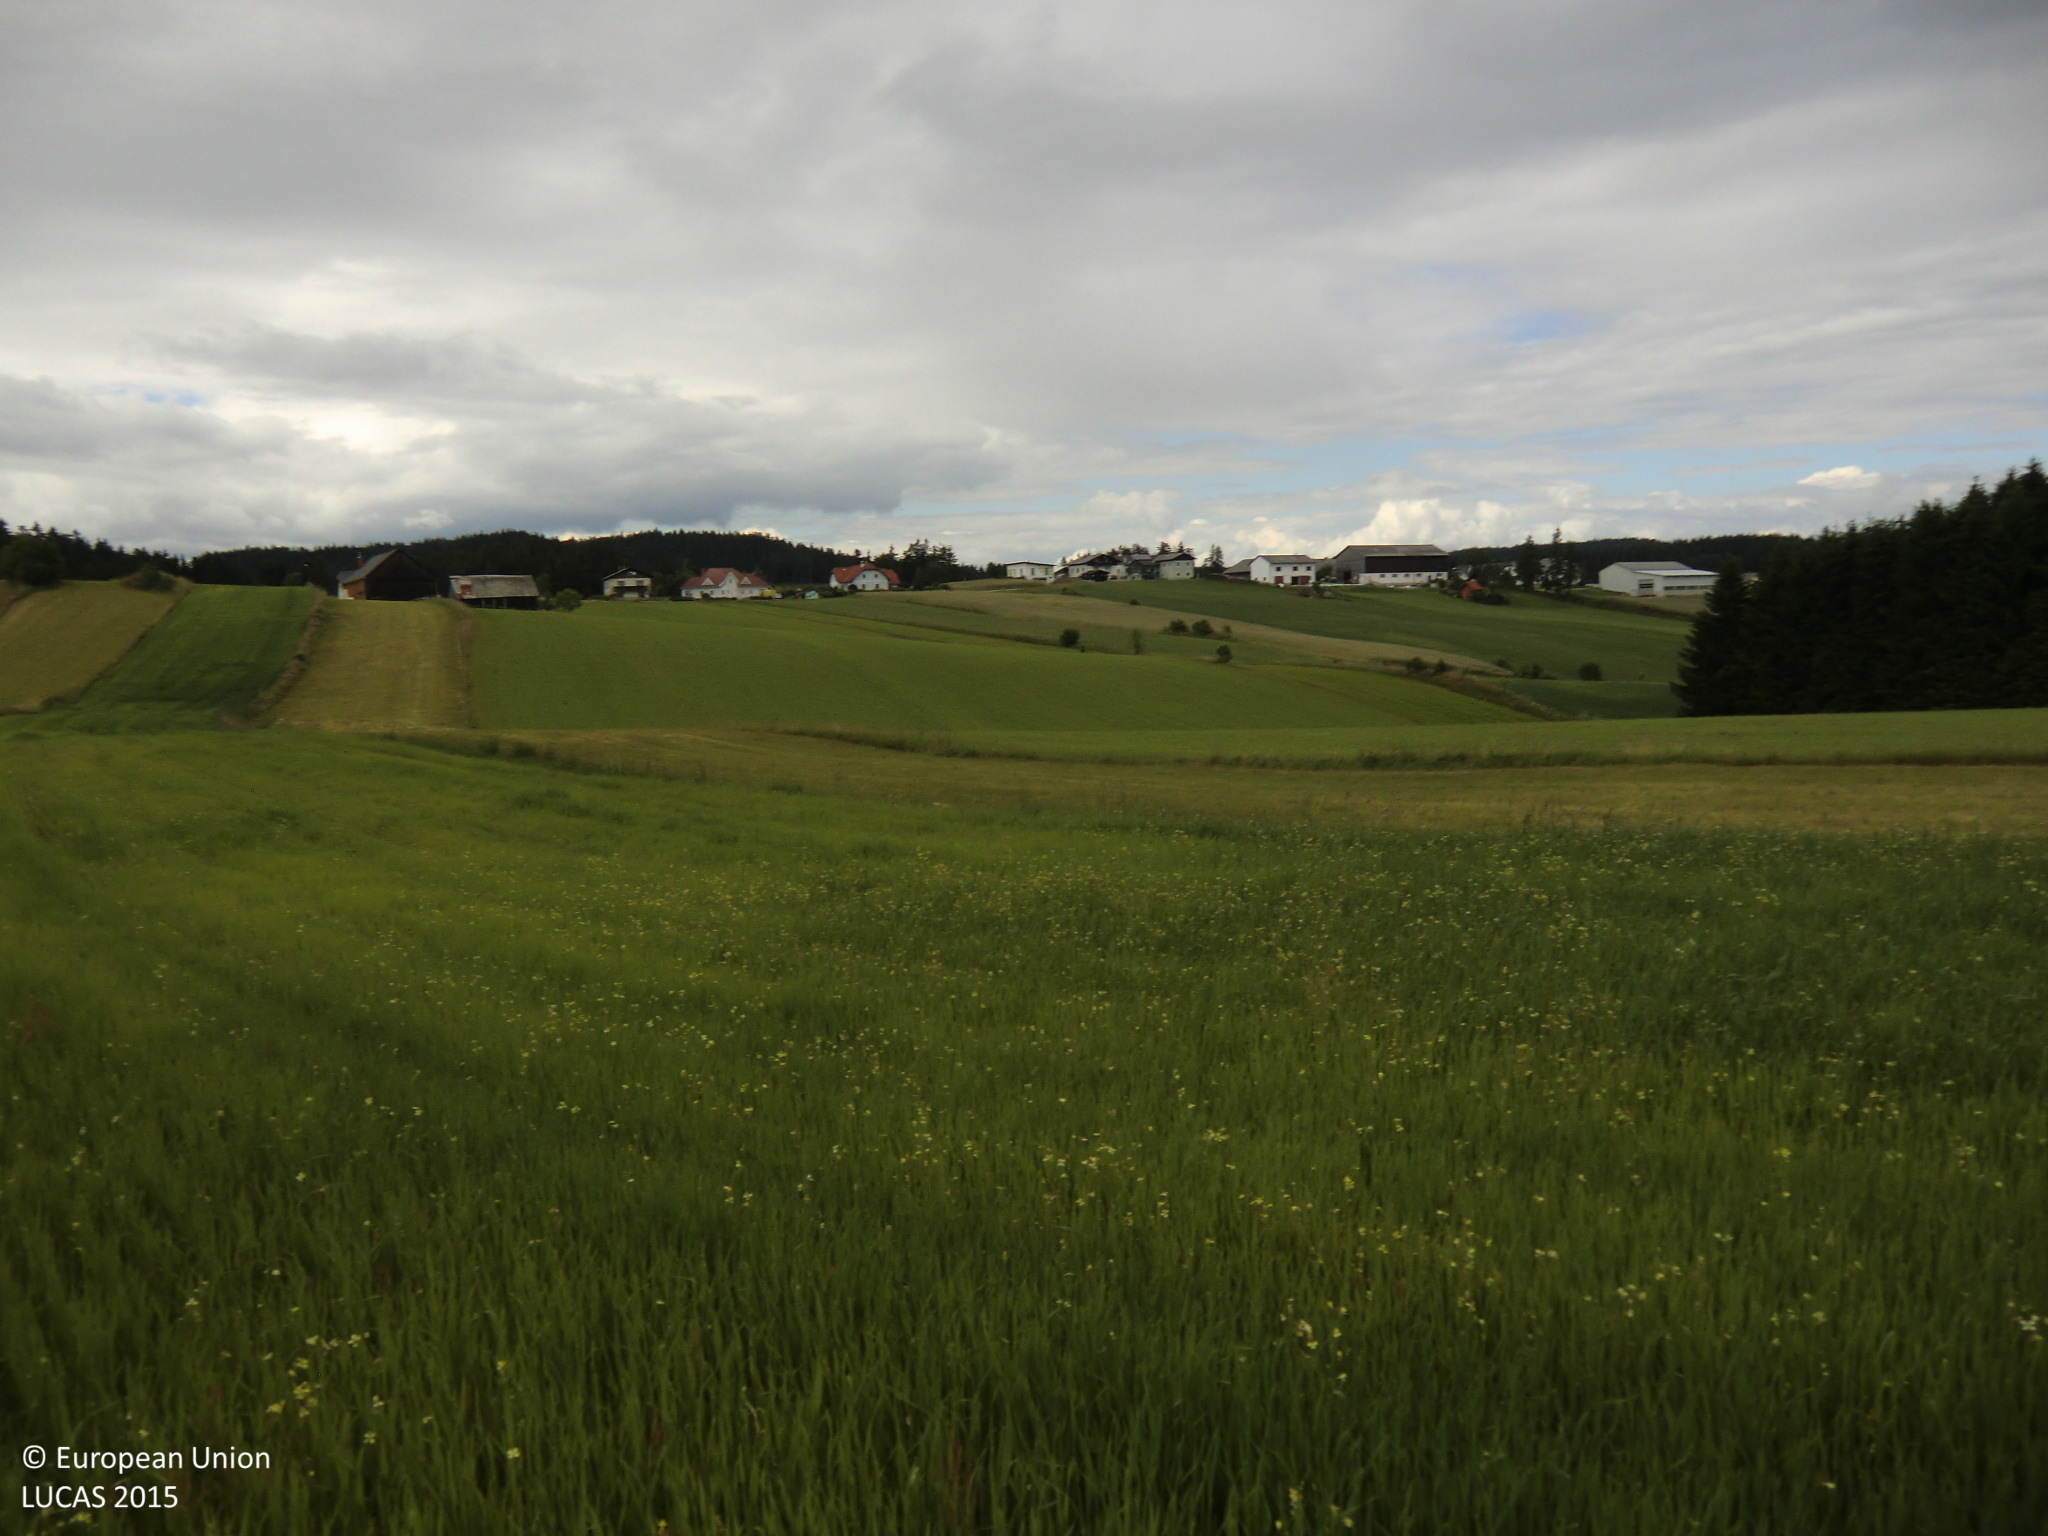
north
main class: Cropland
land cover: Rye
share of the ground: > 75 %
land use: Agriculture (excluding fallow land and kitchen gardens)
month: June
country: AT
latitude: 48.4351
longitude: 14.9891
